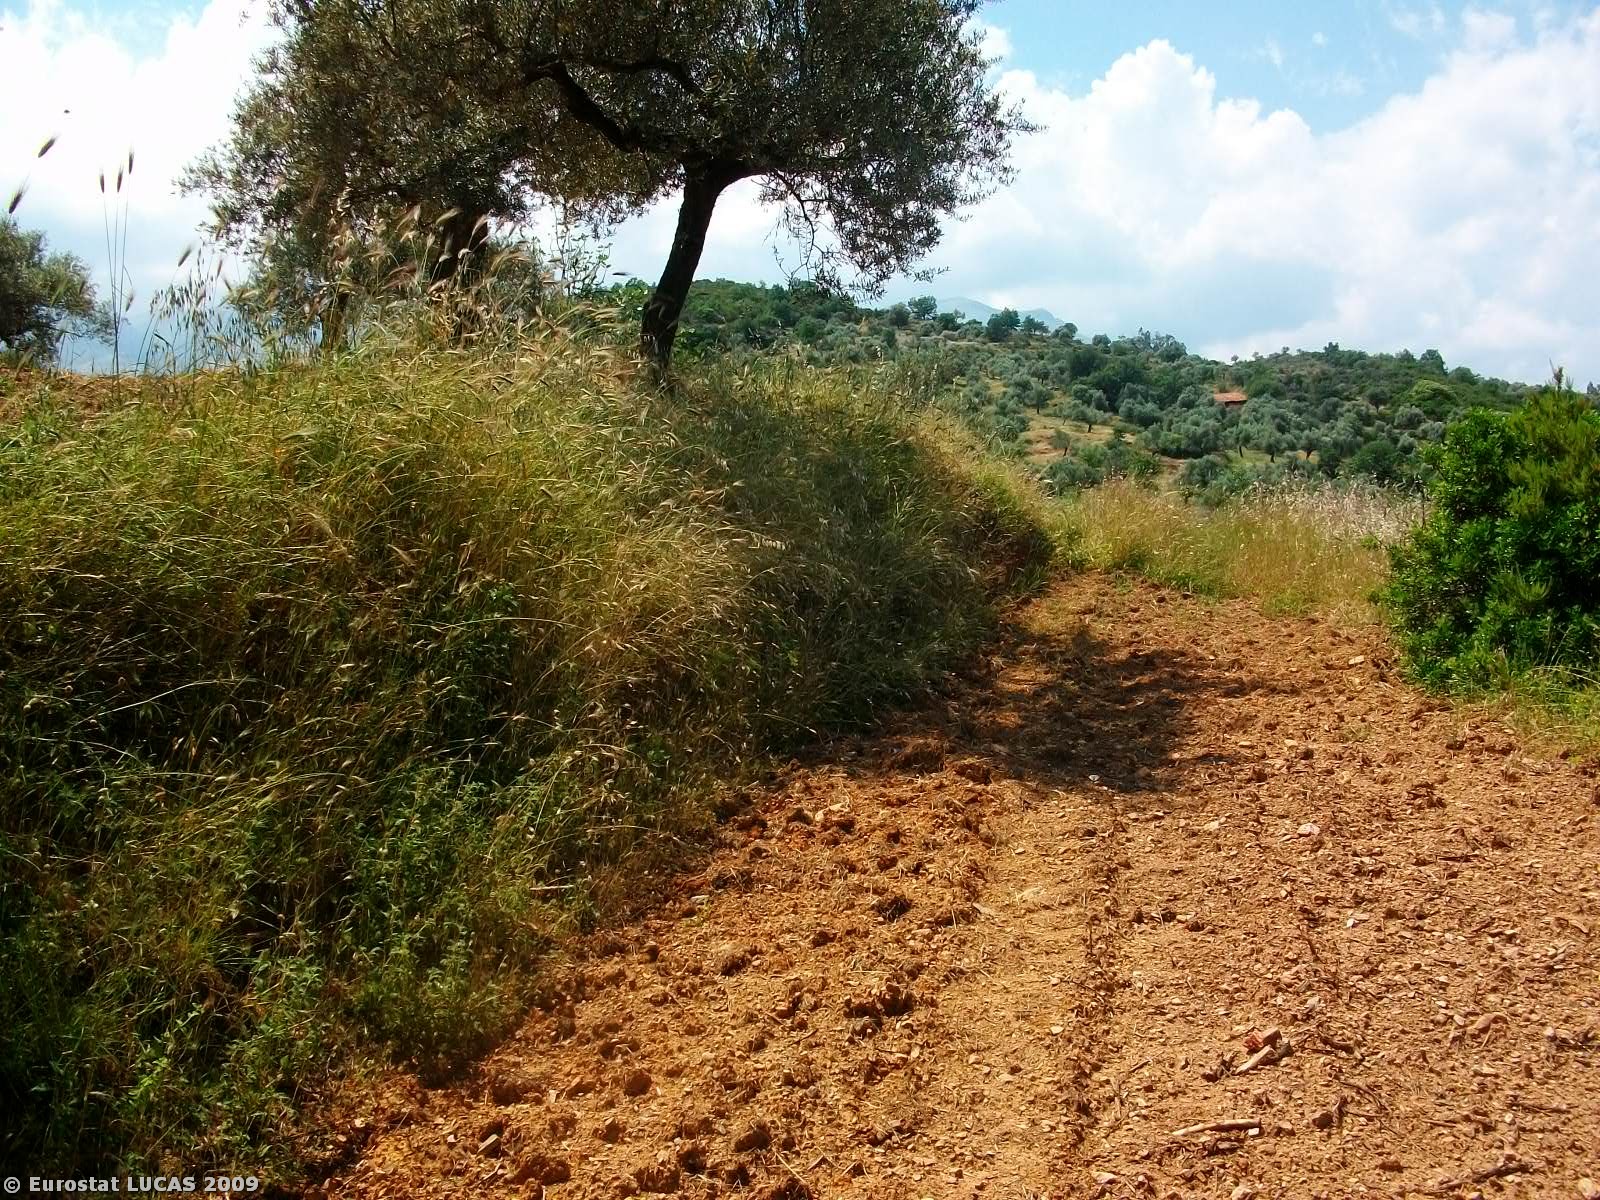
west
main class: Cropland
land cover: Olive groves
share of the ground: 25 - 50 %
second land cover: Bare land
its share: 50 - 75 %
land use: Agriculture (excluding fallow land and kitchen gardens)
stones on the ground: 25 - 50 %
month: May
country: GR
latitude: 37.1198
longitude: 22.3702
